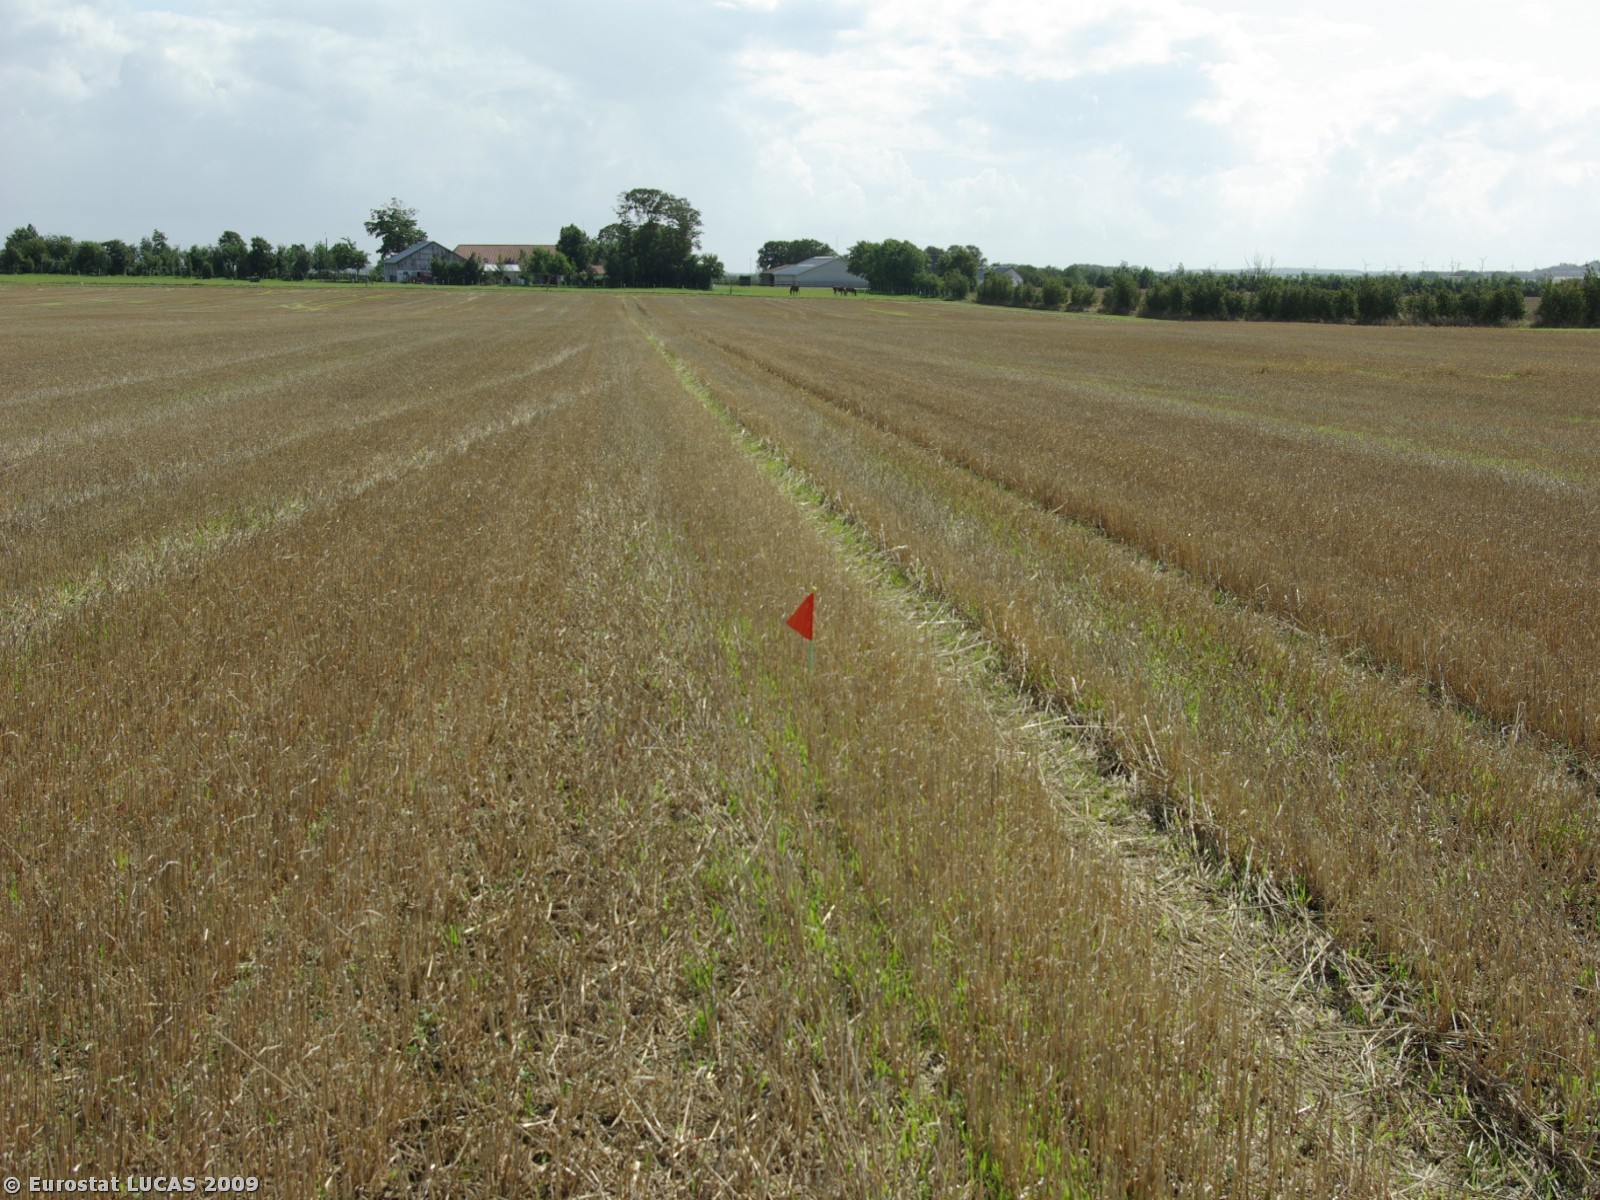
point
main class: Cropland
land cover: Barley
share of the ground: < 10 %
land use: Agriculture (excluding fallow land and kitchen gardens)
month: July
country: DK
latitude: 55.1953
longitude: 9.0111
